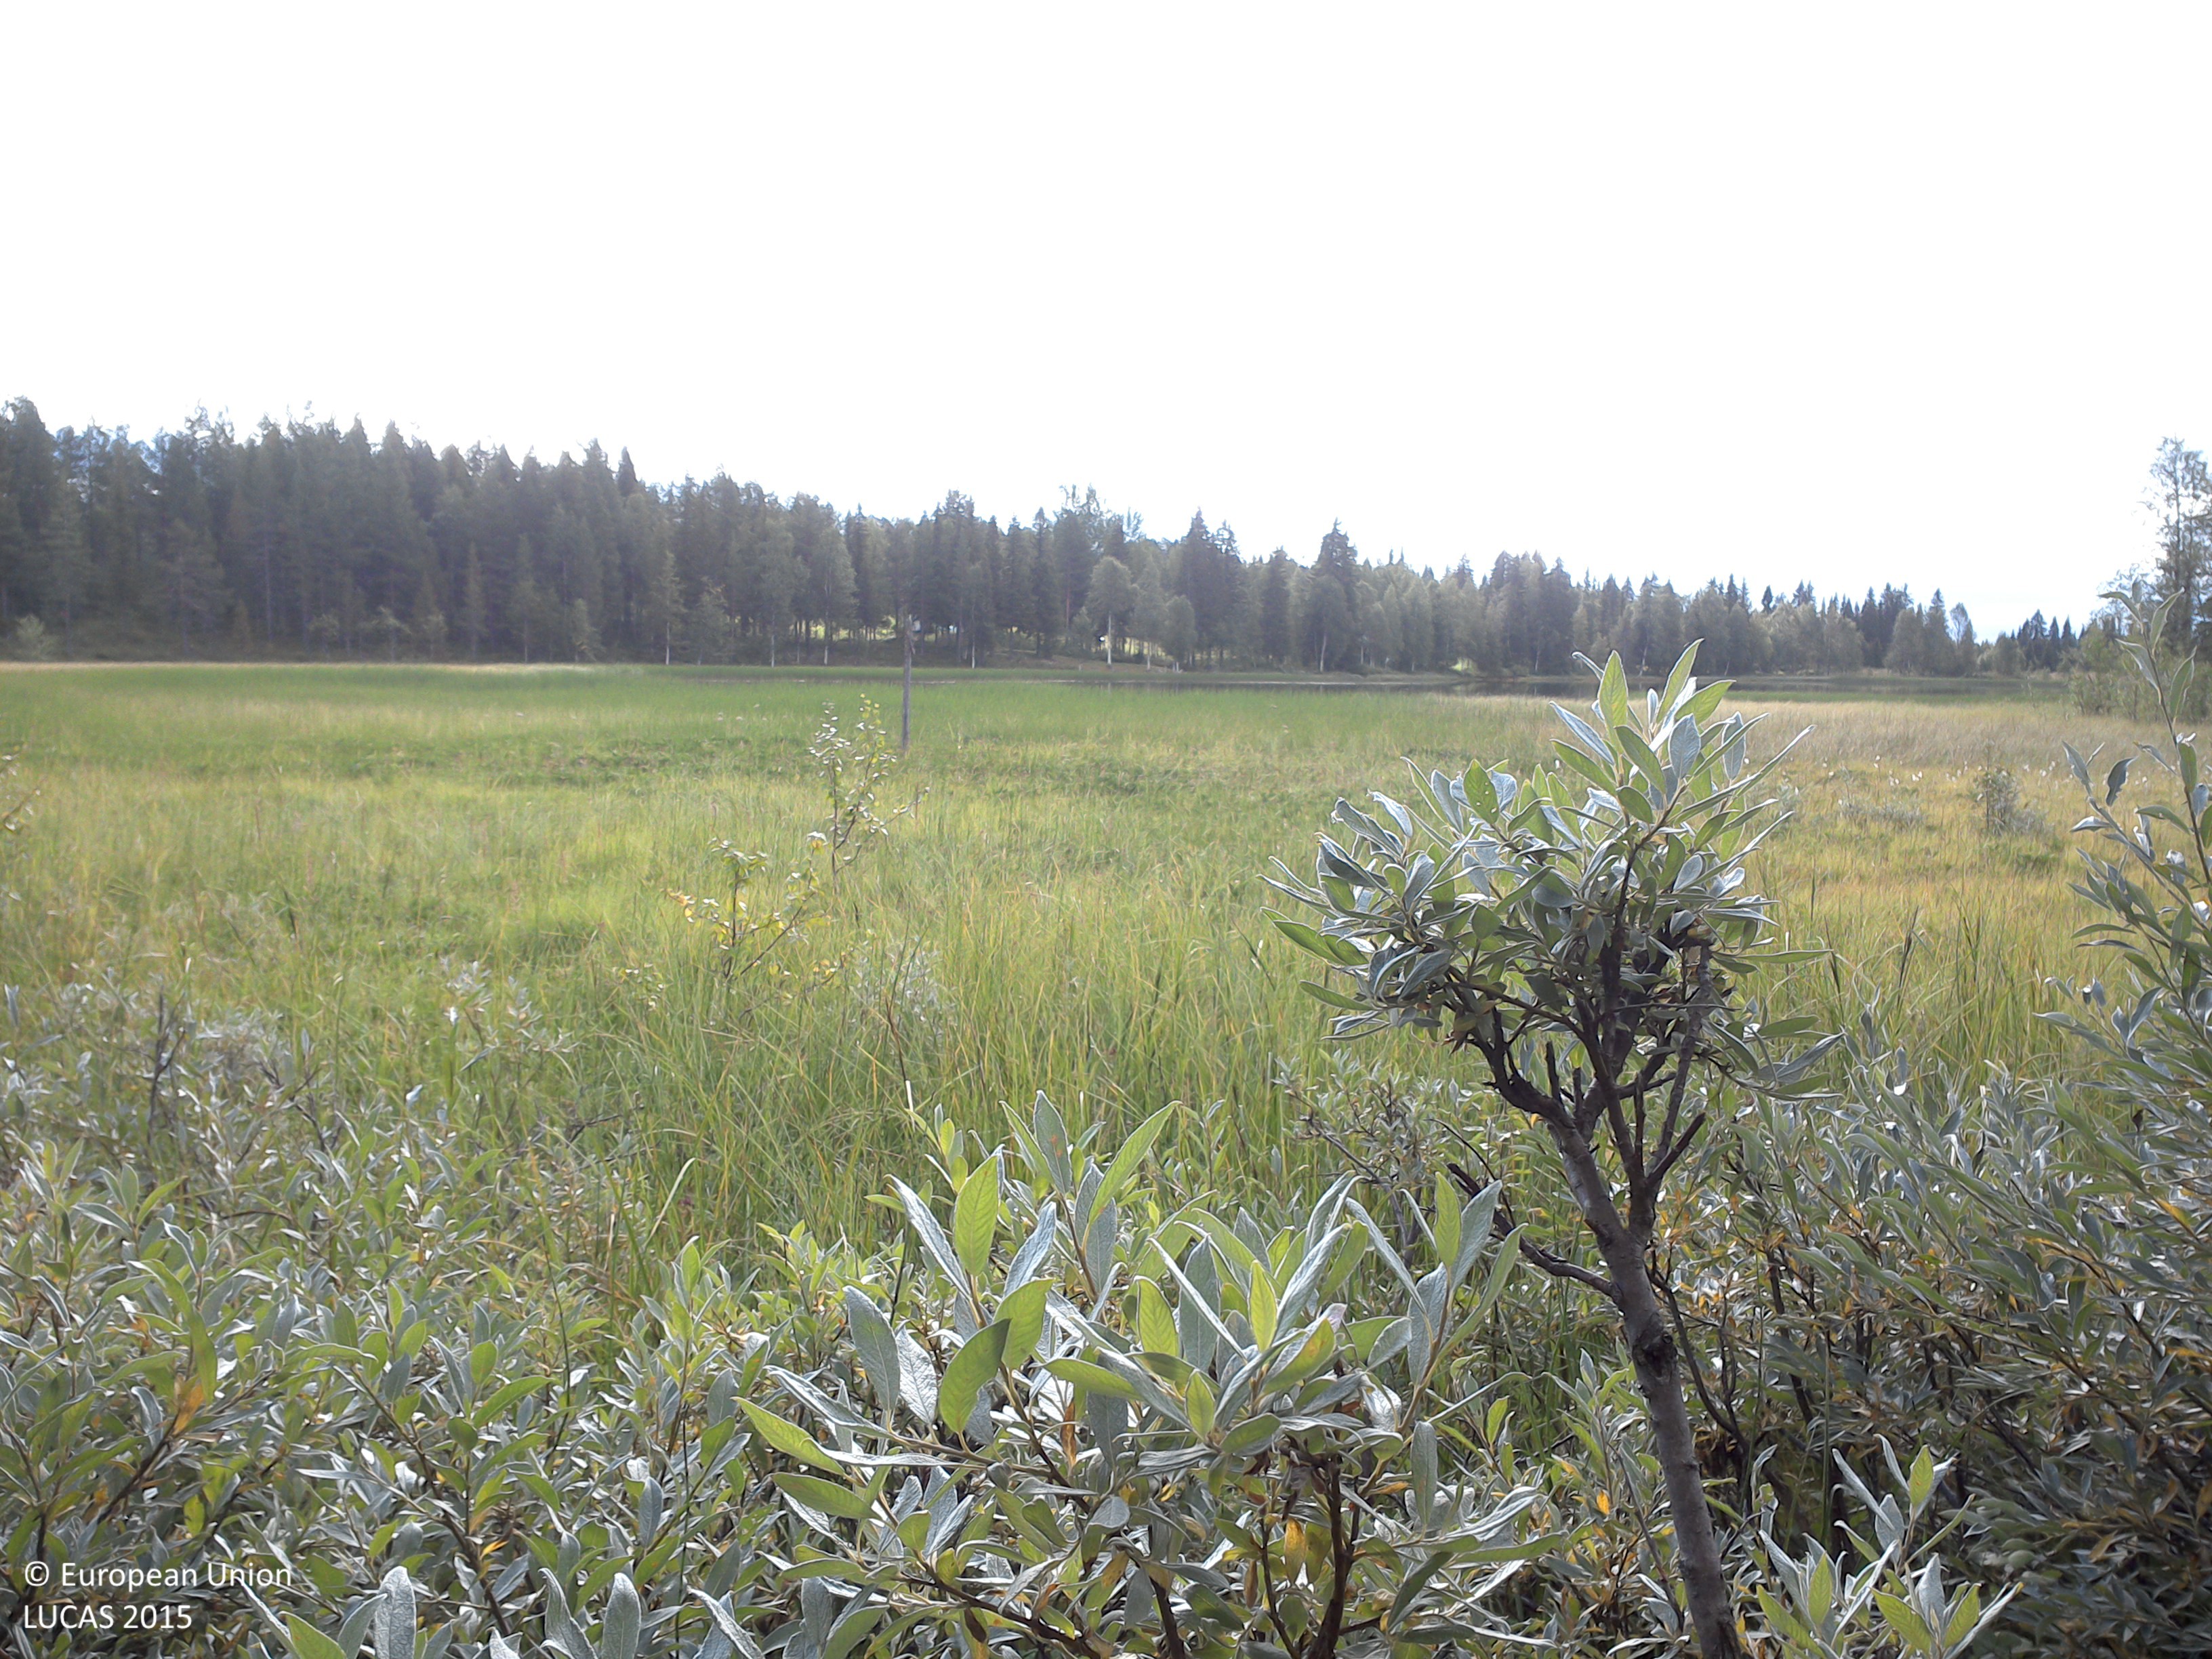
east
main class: Woodland
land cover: Broadleaved woodland
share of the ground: 50 - 75 %
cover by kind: broadleaved forest trees 55 %, shrubs 40 %, herbaceous plants 5 %
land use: Semi-natural and natural areas not in use
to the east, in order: Broadleaved woodland; Peatbogs; Inland marshes; Inland fresh water bodies; Inland marshes; Spruce dominated mixed woodland; Artificial constructions in urban areas; Spruce dominated mixed woodland
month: August
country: SE
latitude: 67.3837
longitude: 21.8144
